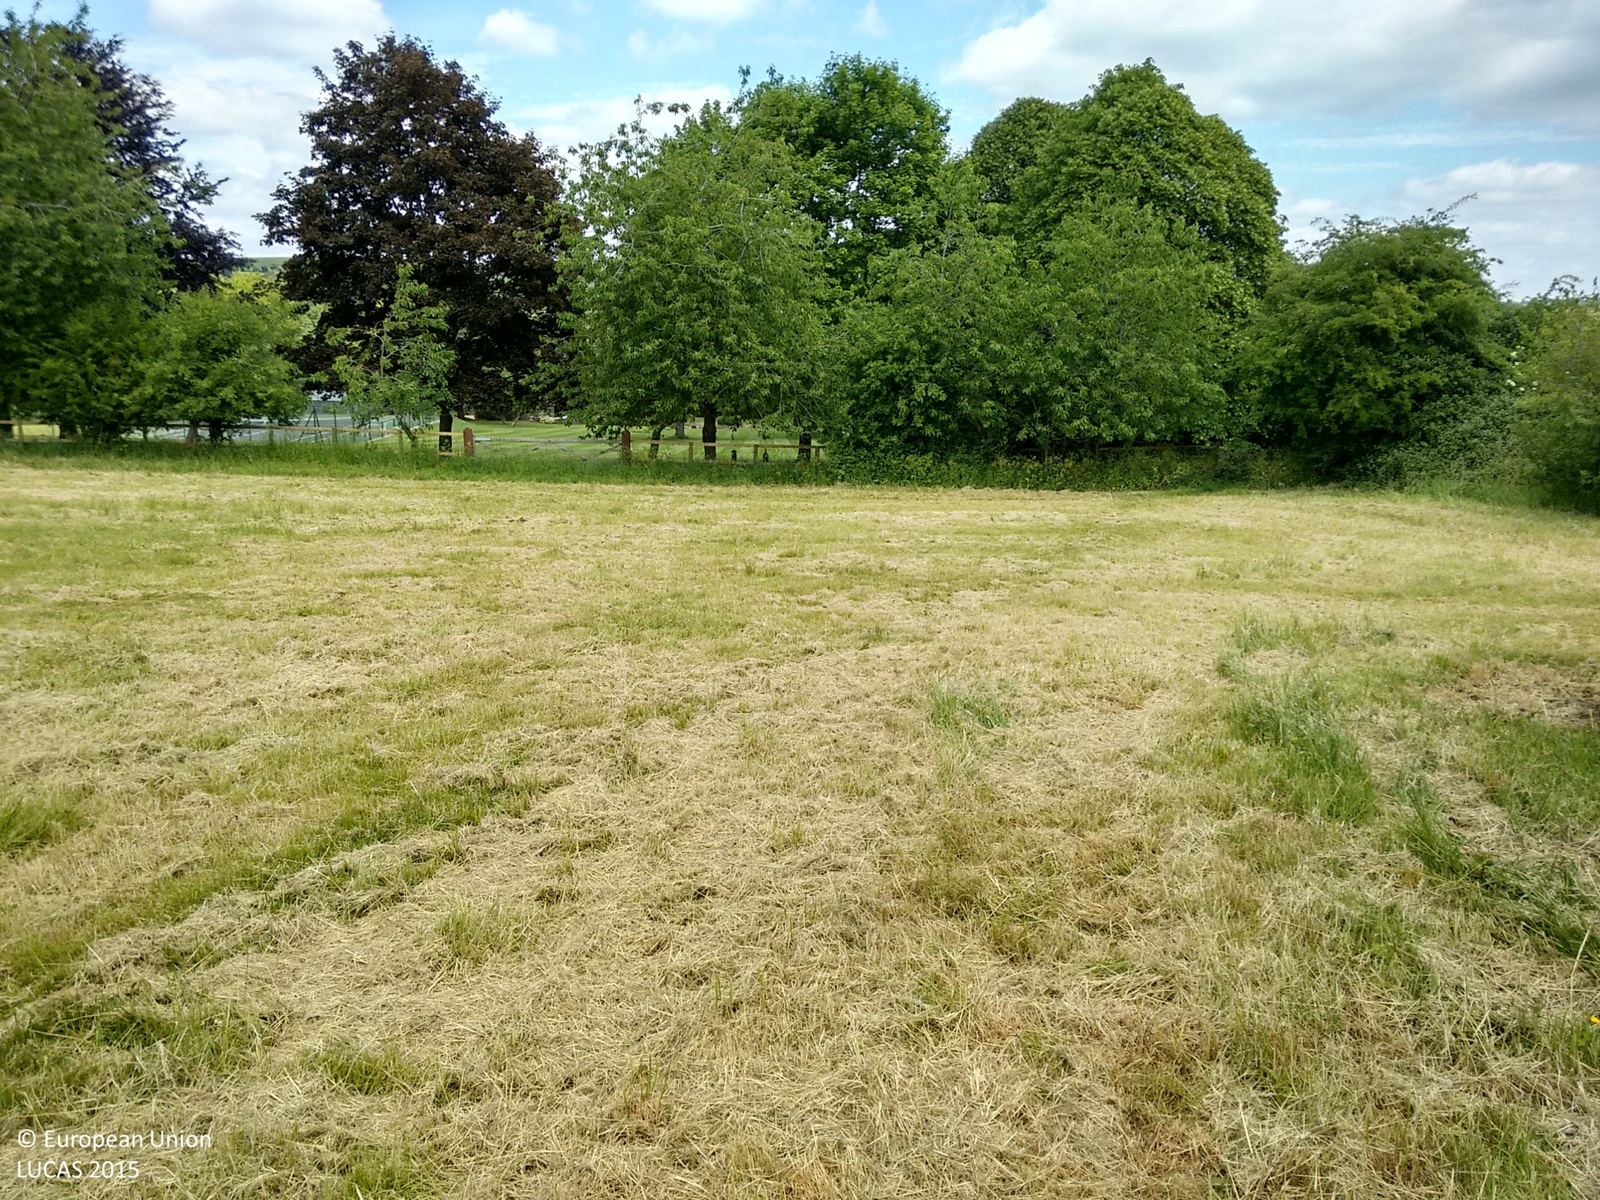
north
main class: Grassland
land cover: Grassland without tree/shrub cover
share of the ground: > 75 %
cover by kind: herbaceous plants 100 %
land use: Agriculture (excluding fallow land and kitchen gardens)
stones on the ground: 10 - 25 %
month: June
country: GB
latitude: 51.4894
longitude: -1.5009
